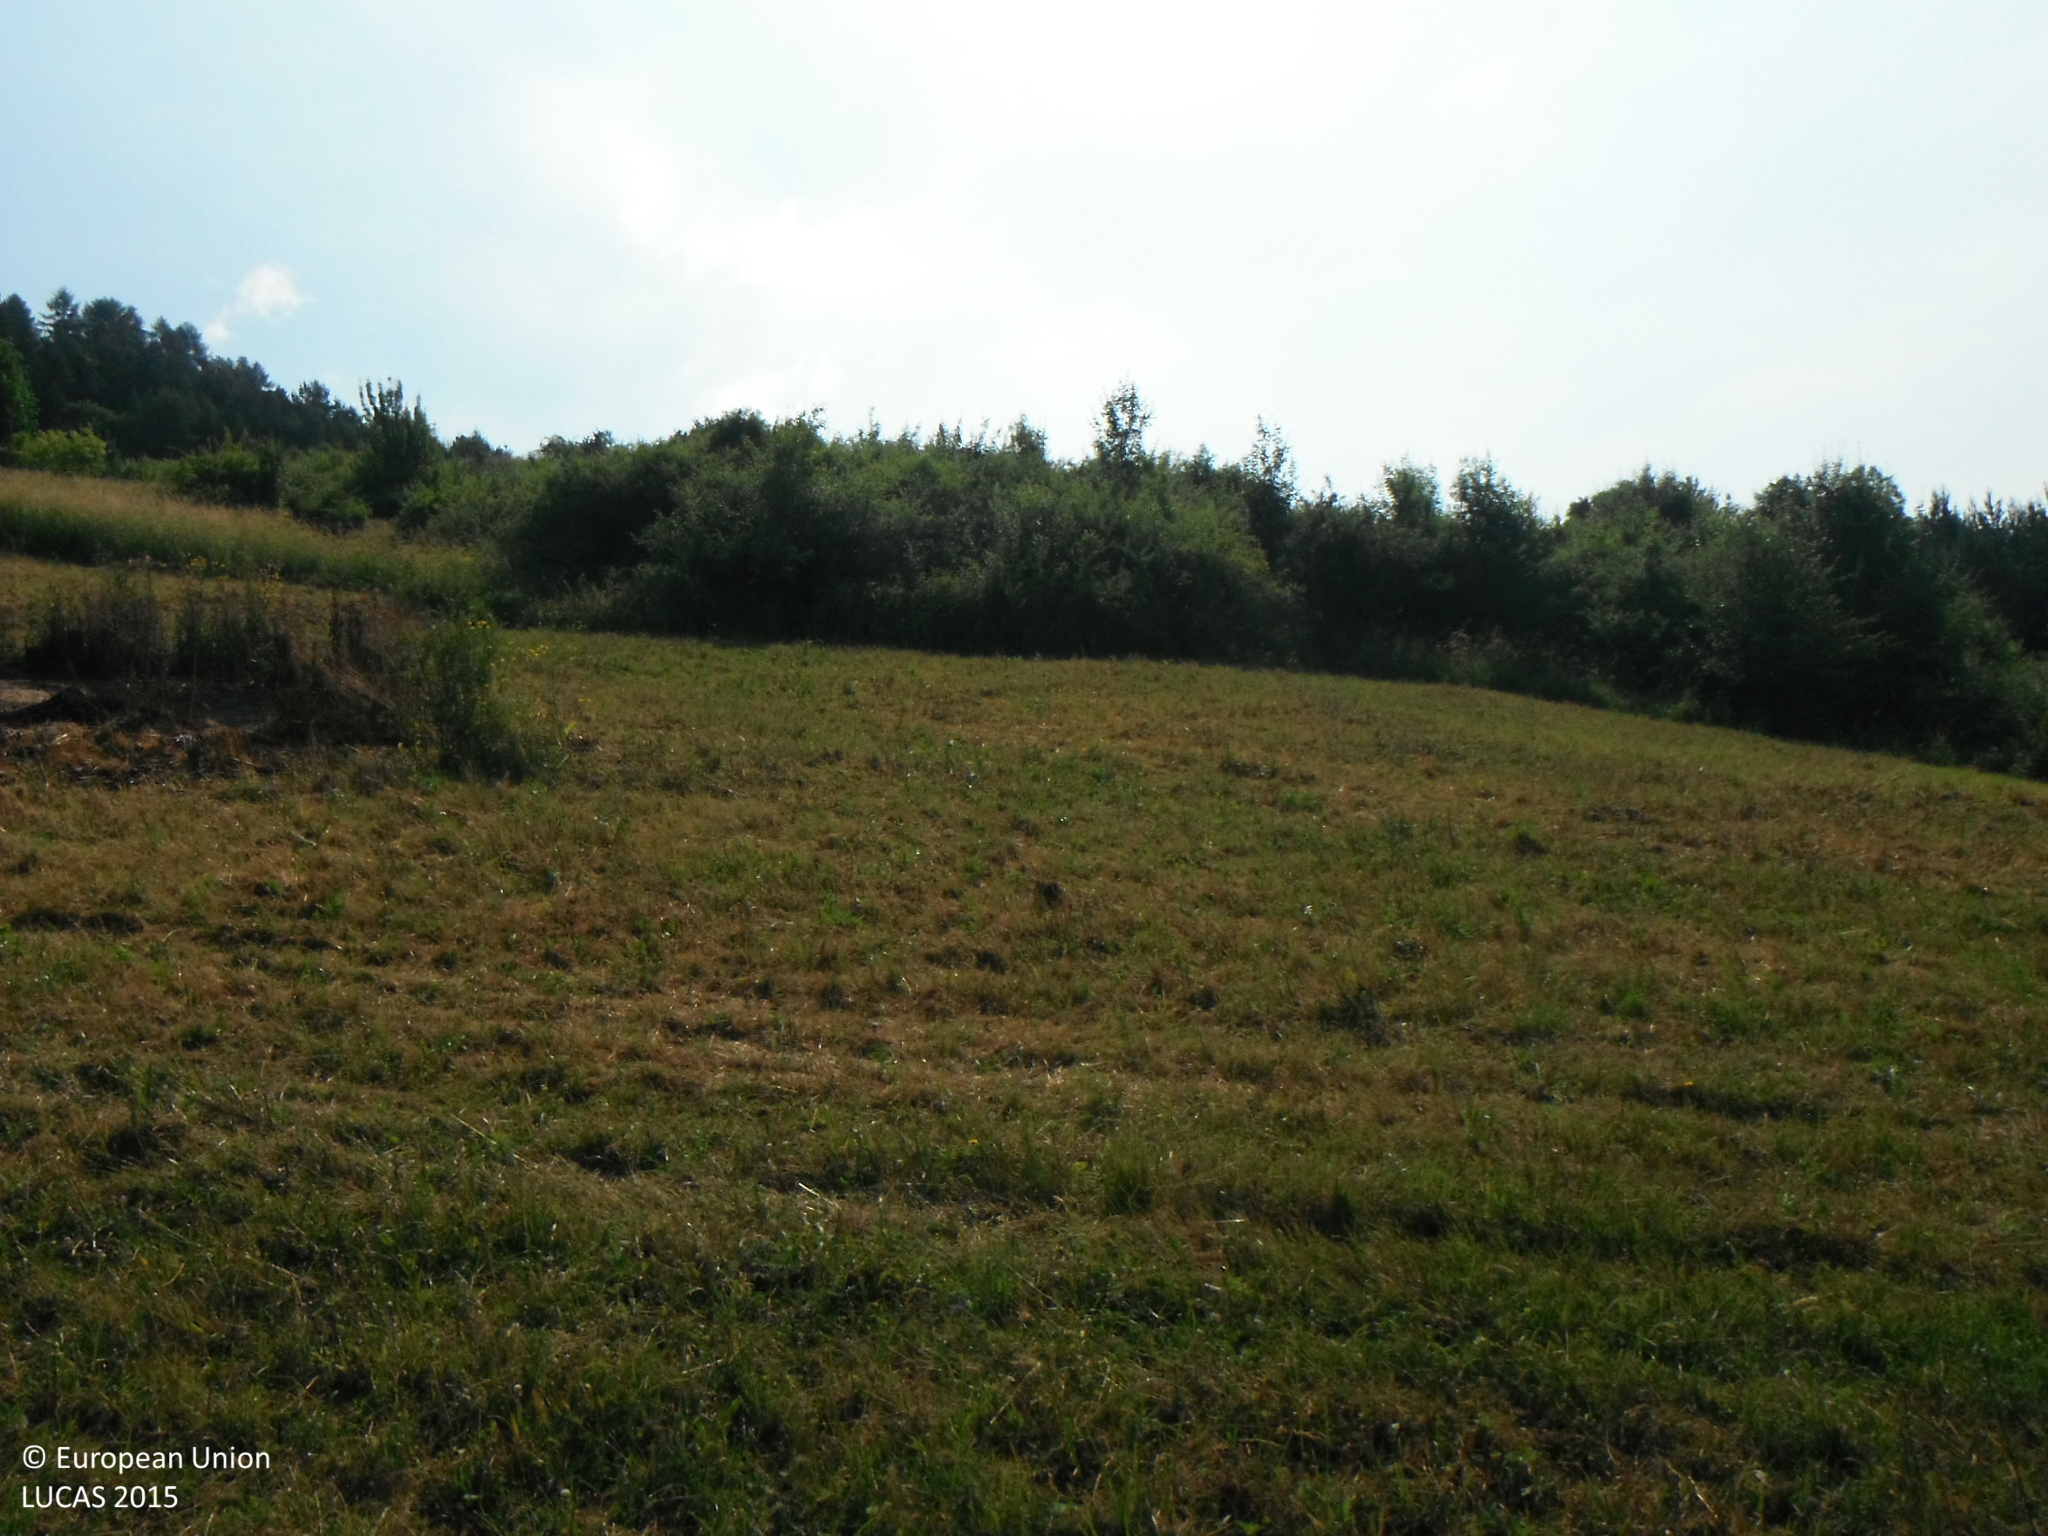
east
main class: Grassland
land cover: Grassland without tree/shrub cover
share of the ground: > 75 %
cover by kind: herbaceous plants 100 %
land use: Agriculture (excluding fallow land and kitchen gardens)
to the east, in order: Grassland without tree/shrub cover; Shrubland without tree cover; Grassland with sparse tree/shrub cover; Shrubland without tree cover; Grassland with sparse tree/shrub cover; Shrubland without tree cover; Grassland with sparse tree/shrub cover; Tracks; Shrubland without tree cover; Broadleaved woodland
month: July
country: SK
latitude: 49.1017
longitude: 19.4629
